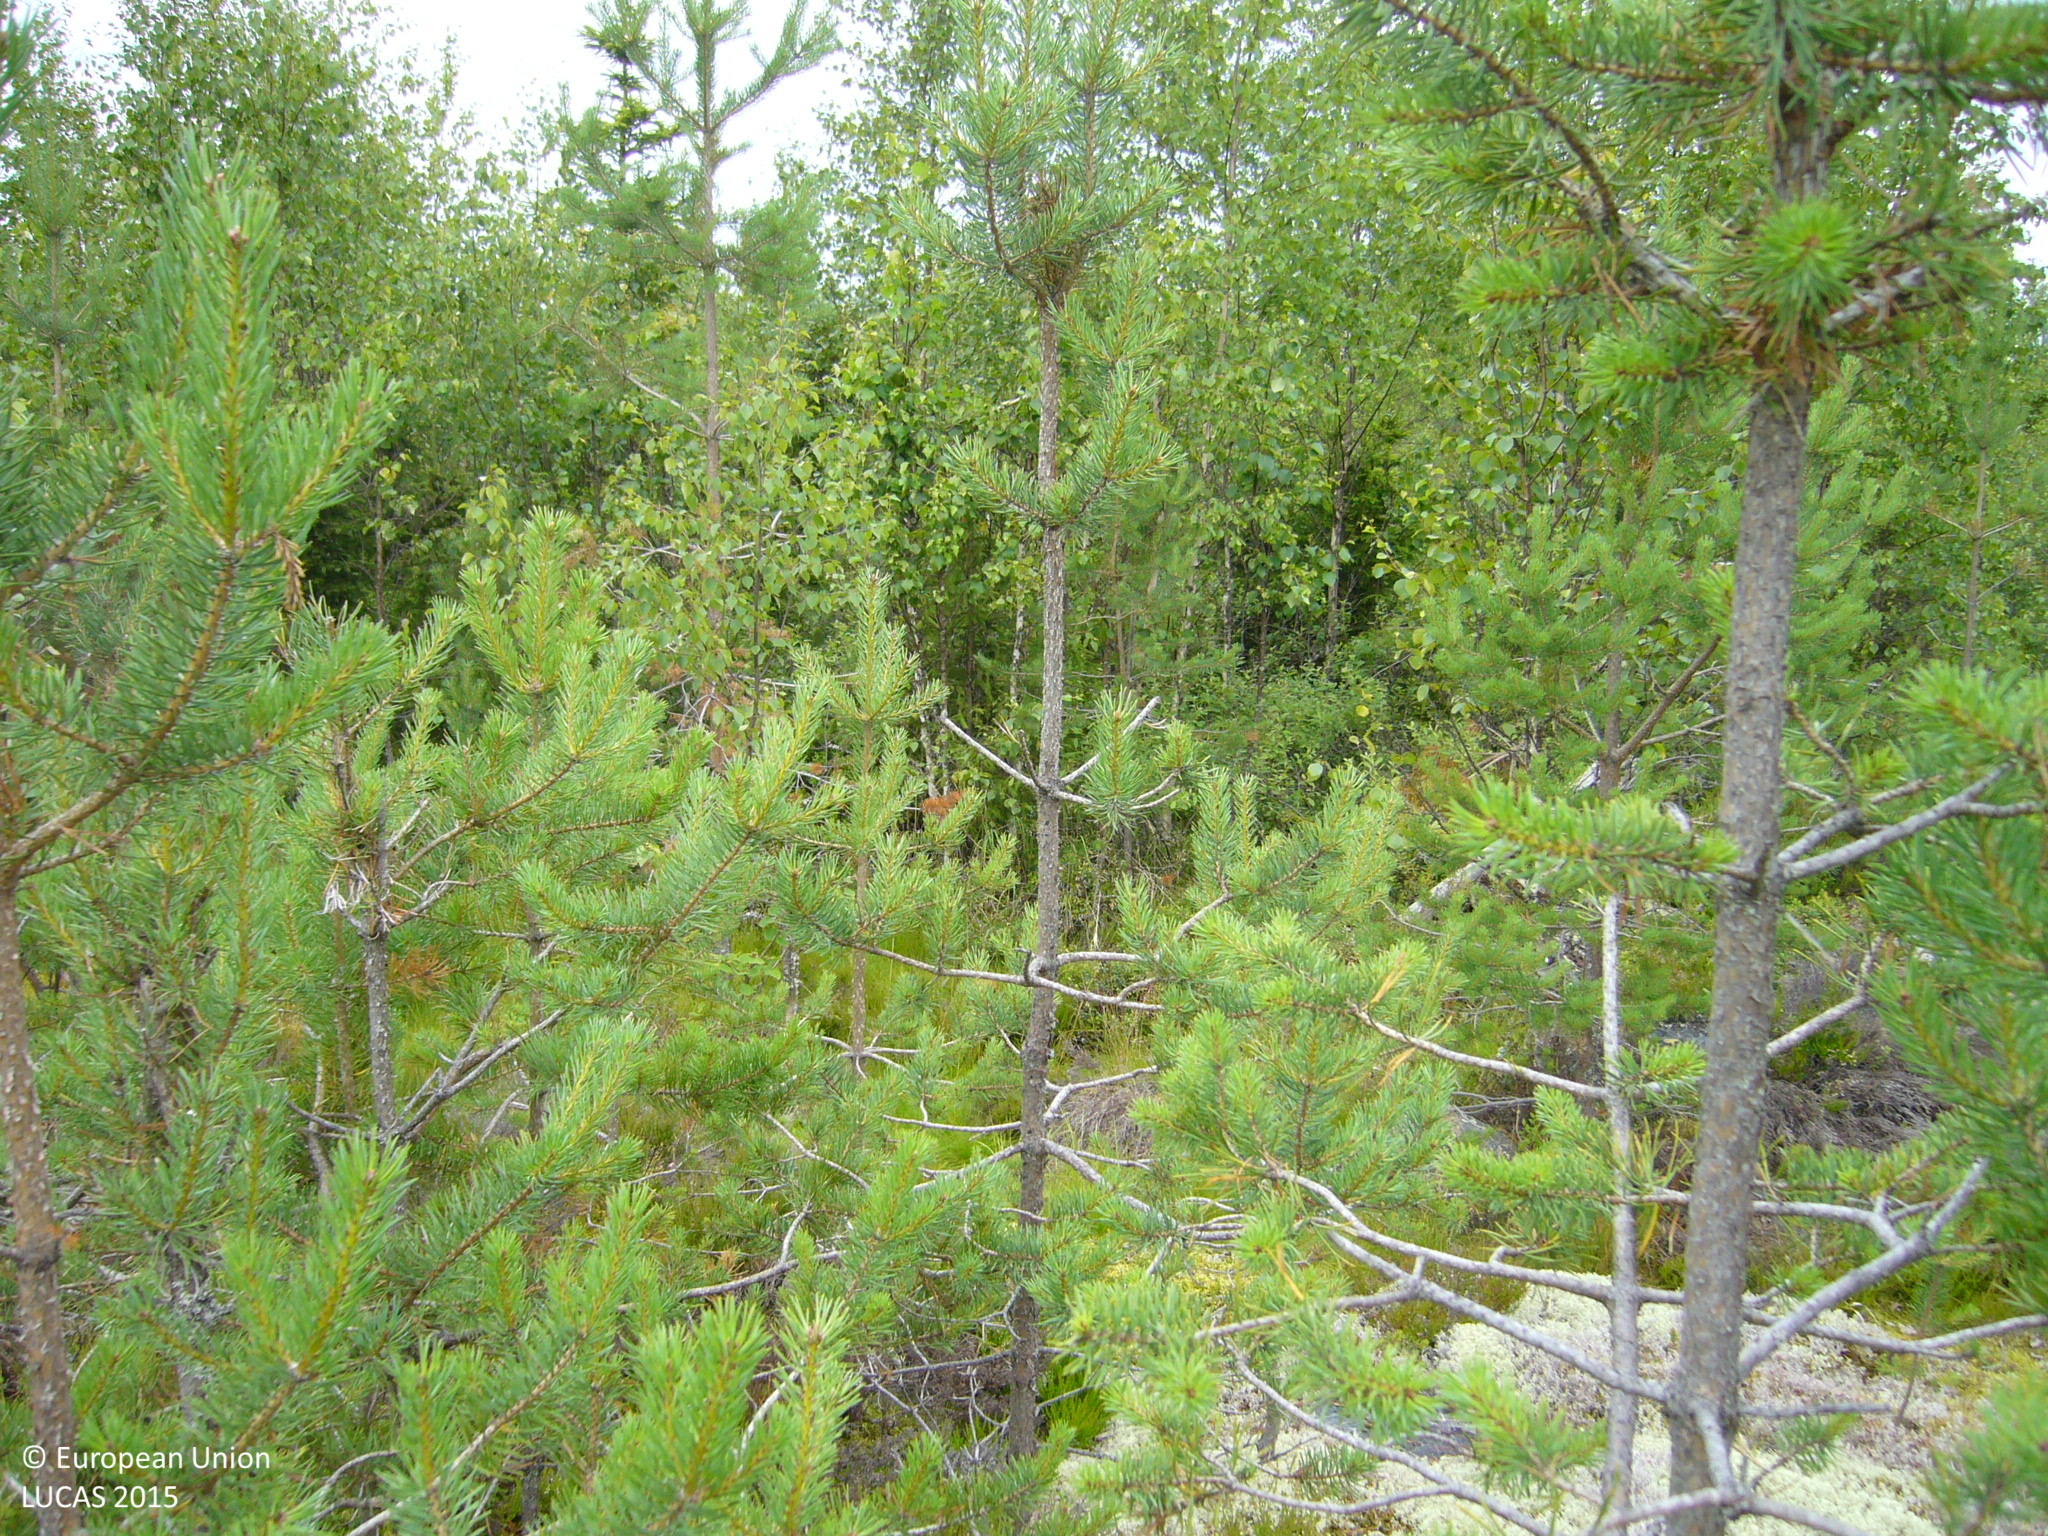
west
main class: Woodland
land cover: Pine dominated mixed woodland
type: boreal forest
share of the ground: 50 - 75 %
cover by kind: coniferous forest trees 30 %, lichens and mosses 30 %, broadleaved forest trees 20 %, consolidated bare surface 20 %
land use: Forestry
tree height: < 5 m
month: July
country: FI
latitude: 63.9447
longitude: 26.2139
